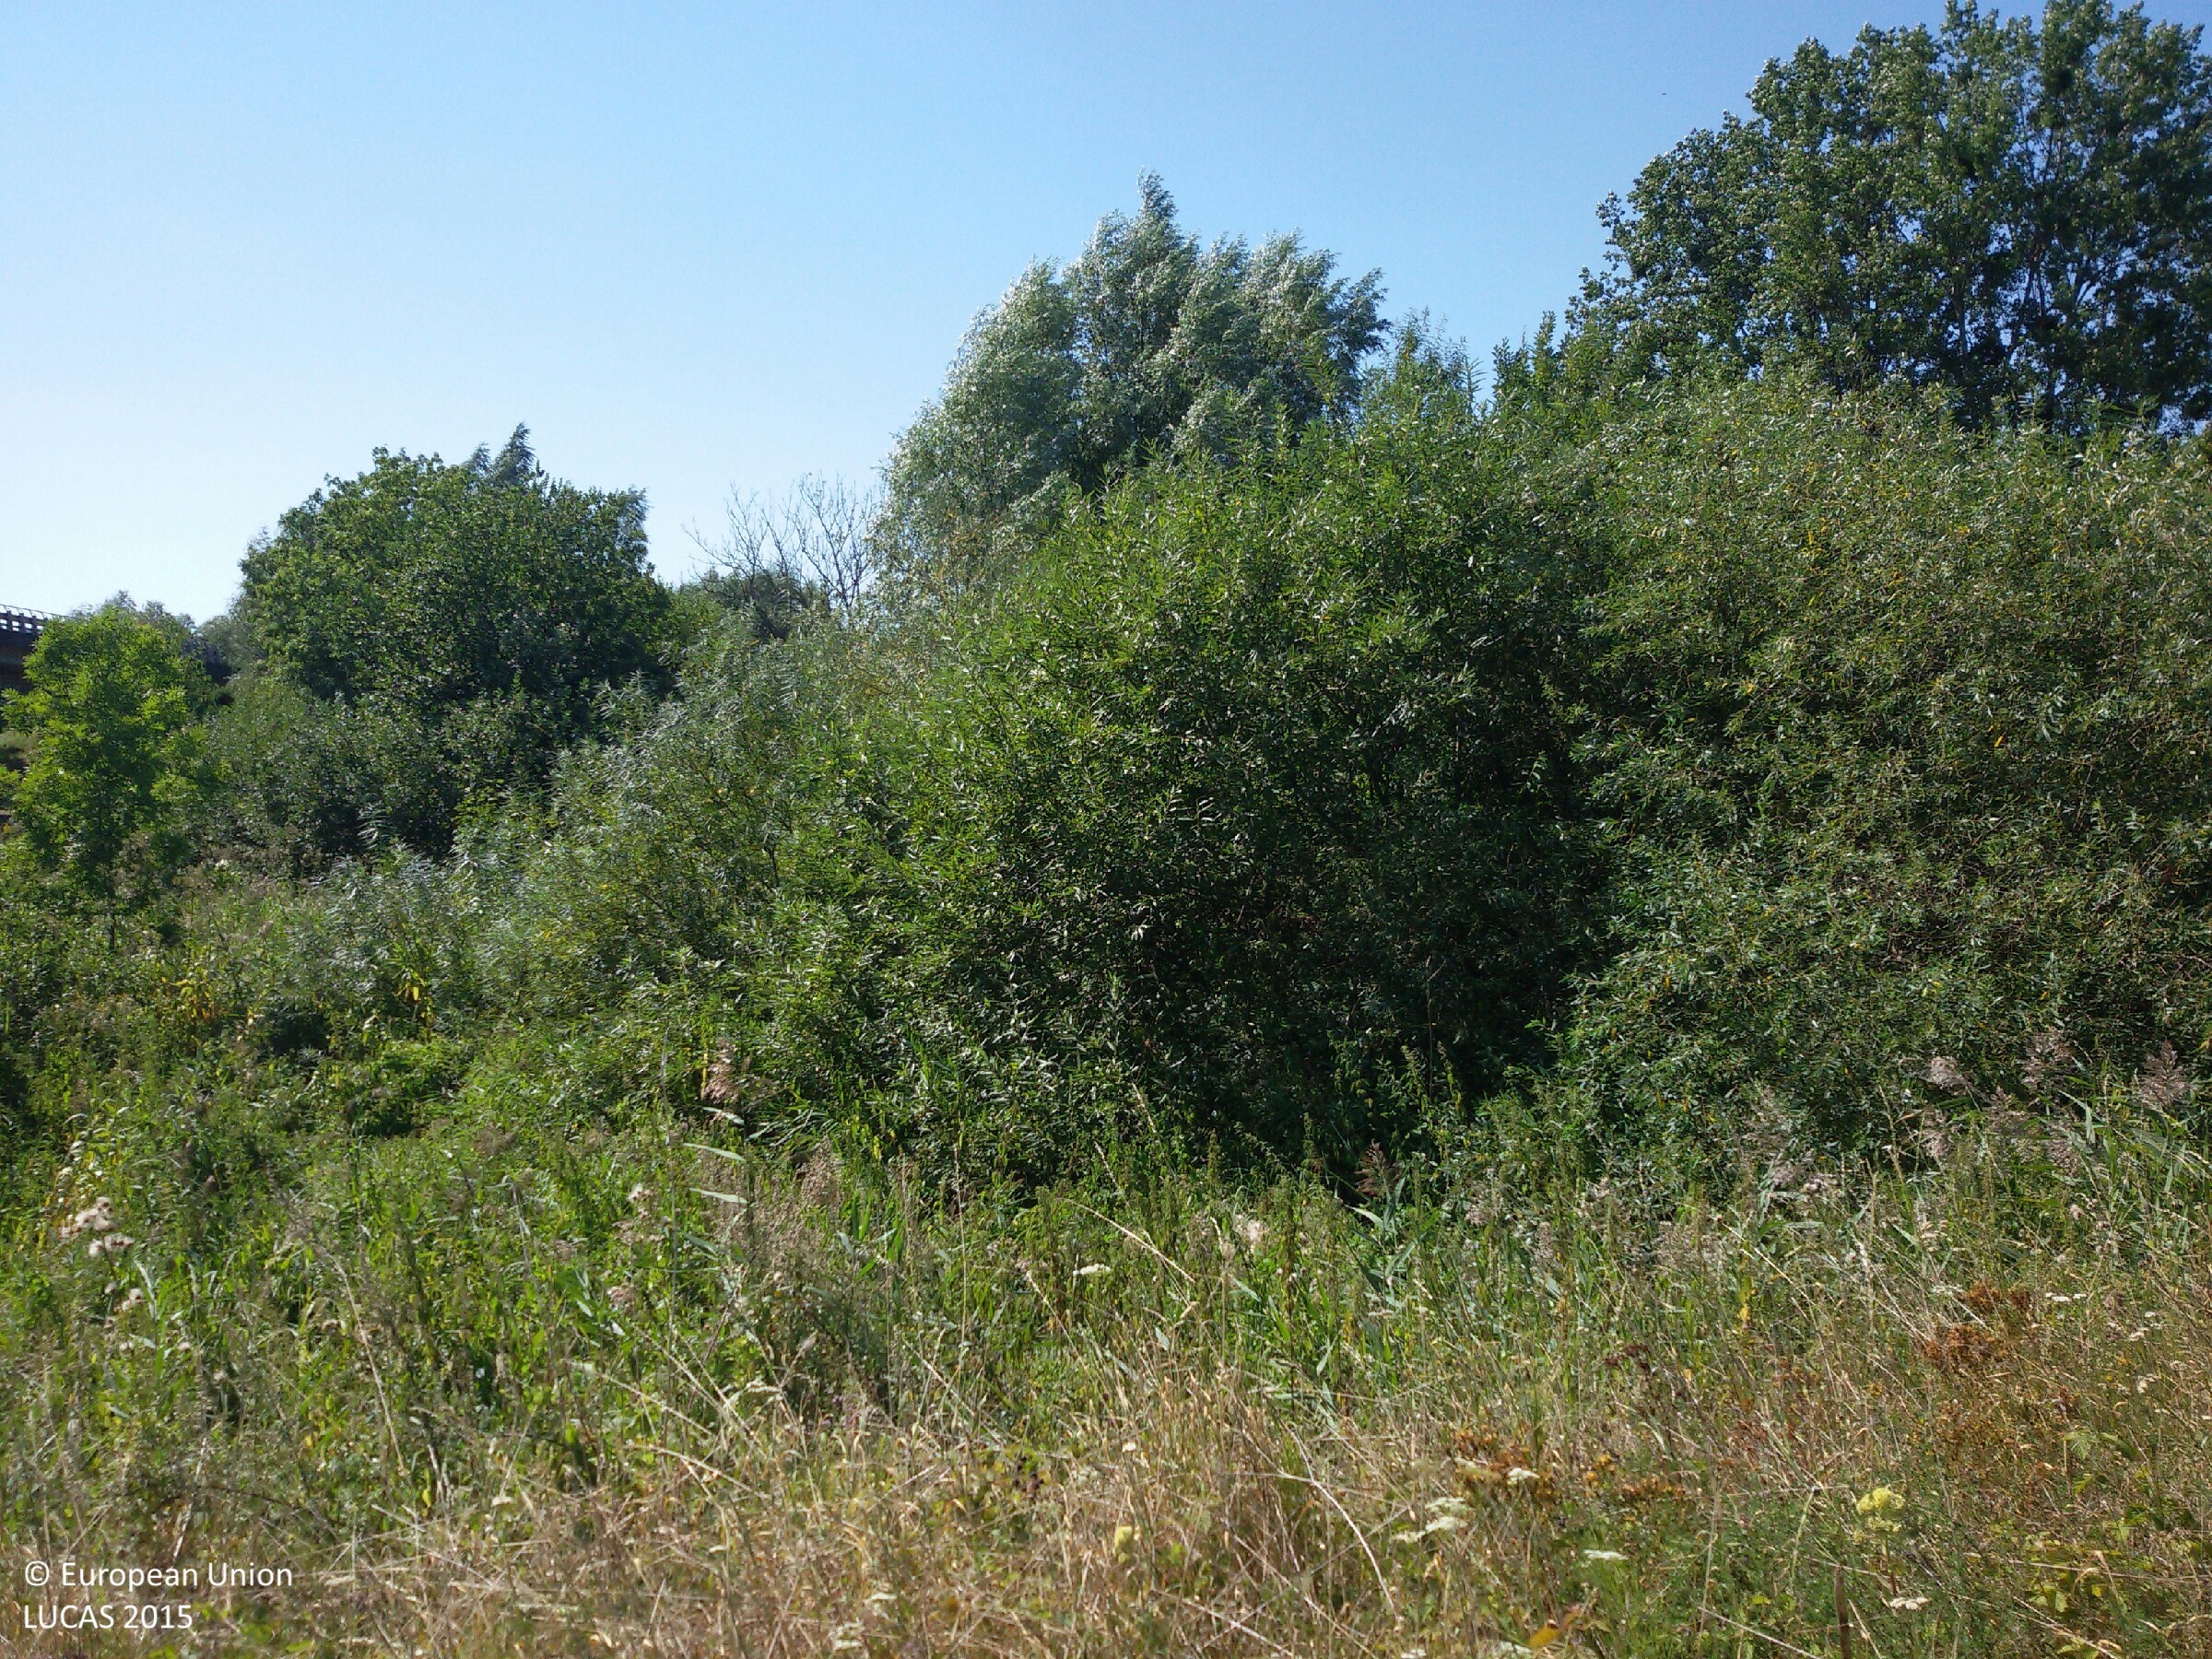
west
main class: Grassland
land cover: Spontaneously vegetated surfaces
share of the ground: > 75 %
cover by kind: herbaceous plants 95 %, shrubs 5 %
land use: Semi-natural and natural areas not in use
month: August
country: PL
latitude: 54.1417
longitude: 19.3777
